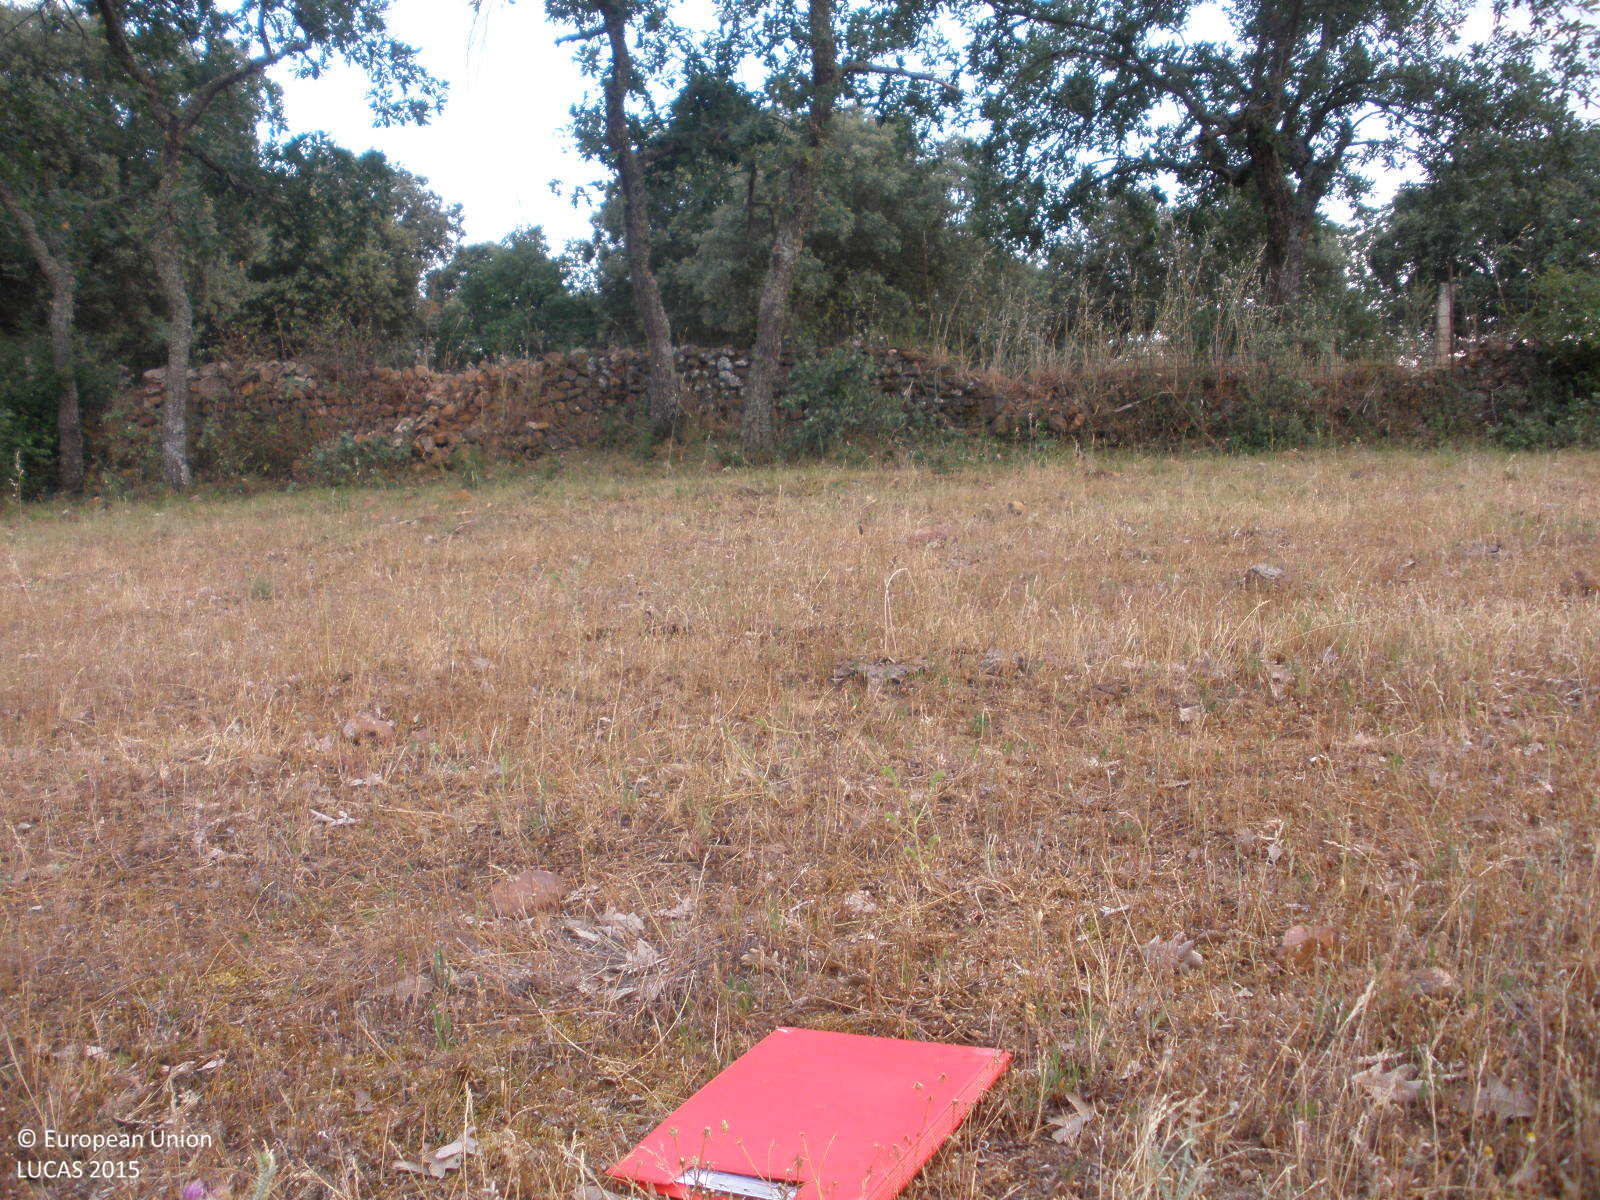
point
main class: Grassland
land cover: Grassland with sparse tree/shrub cover
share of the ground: > 75 %
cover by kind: herbaceous plants 95 %, broadleaved forest trees 5 %
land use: Agriculture (excluding fallow land and kitchen gardens)
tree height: > 5 m
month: June
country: ES
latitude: 40.6959
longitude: -6.3113
